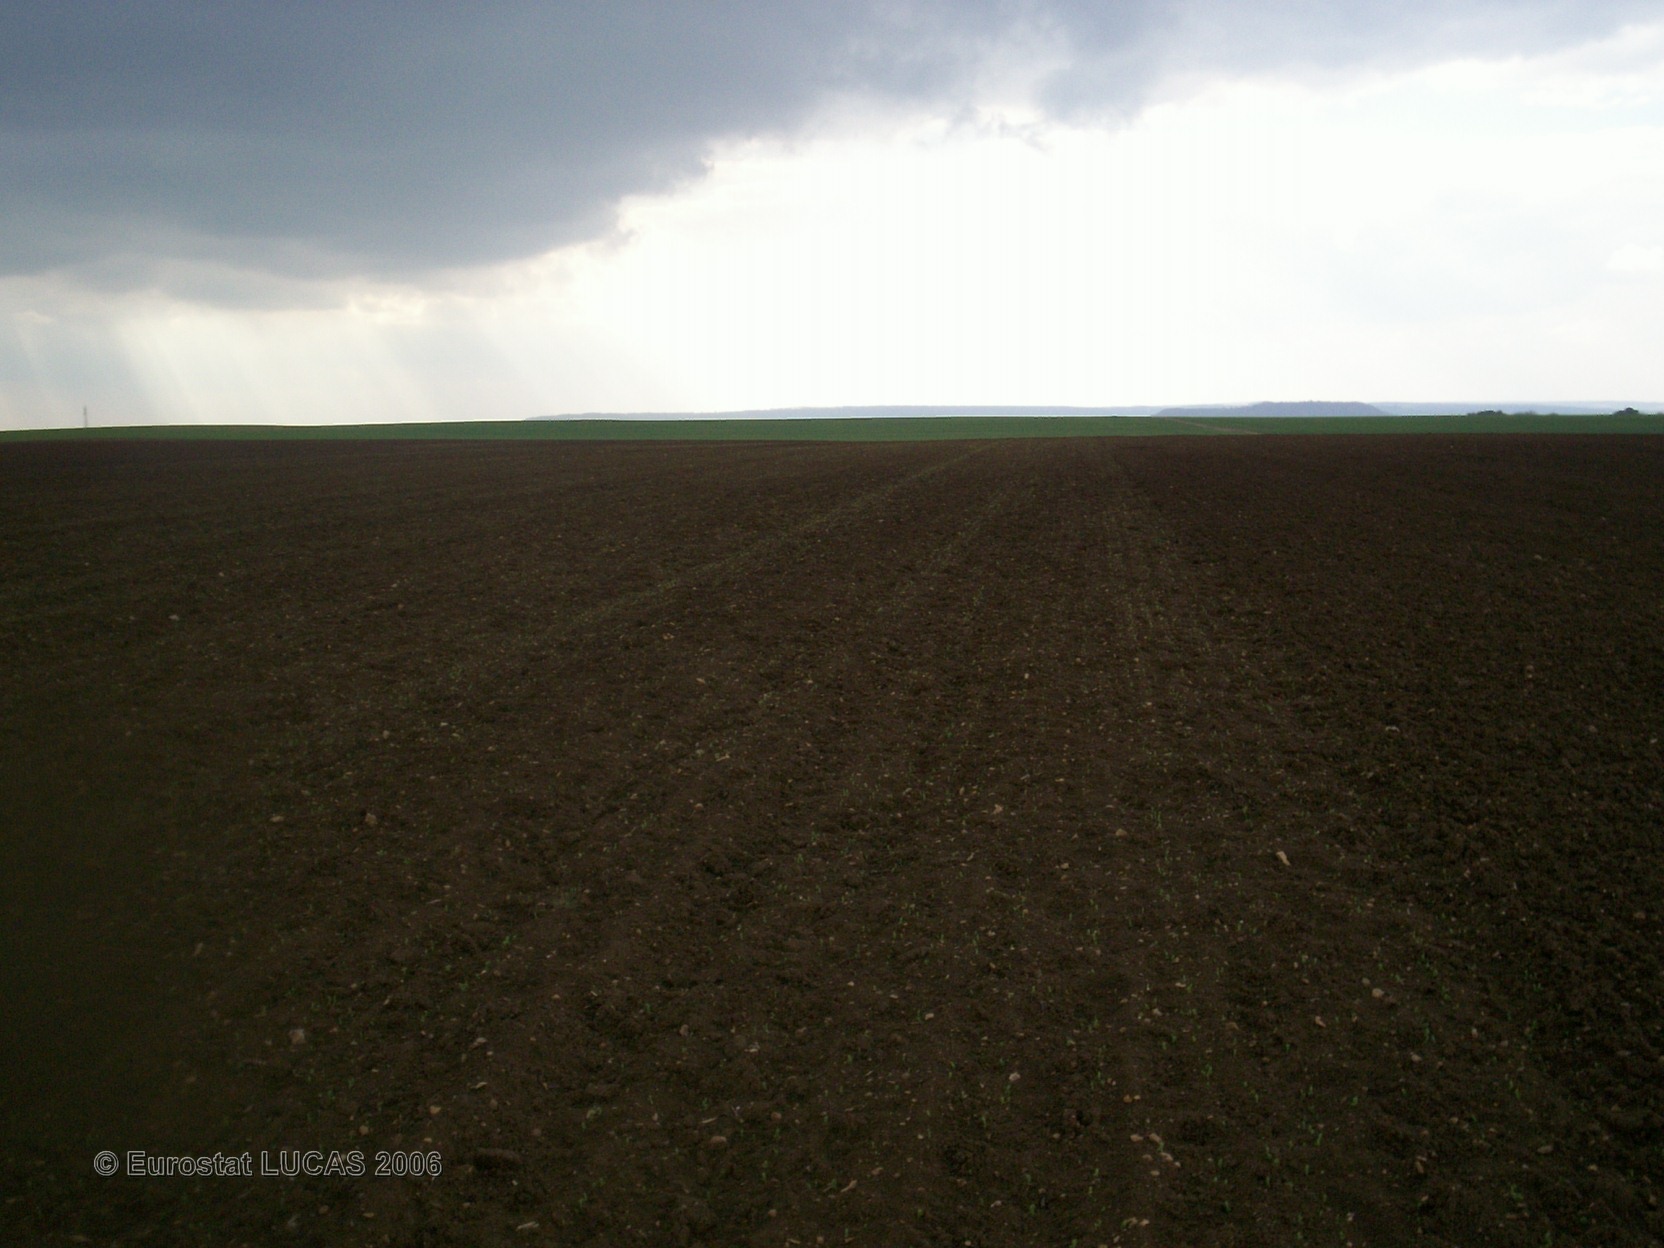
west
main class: Cropland
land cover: Dry pulses
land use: Agriculture (excluding fallow land and kitchen gardens)
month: April
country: FR
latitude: 47.8753
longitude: 4.6103
